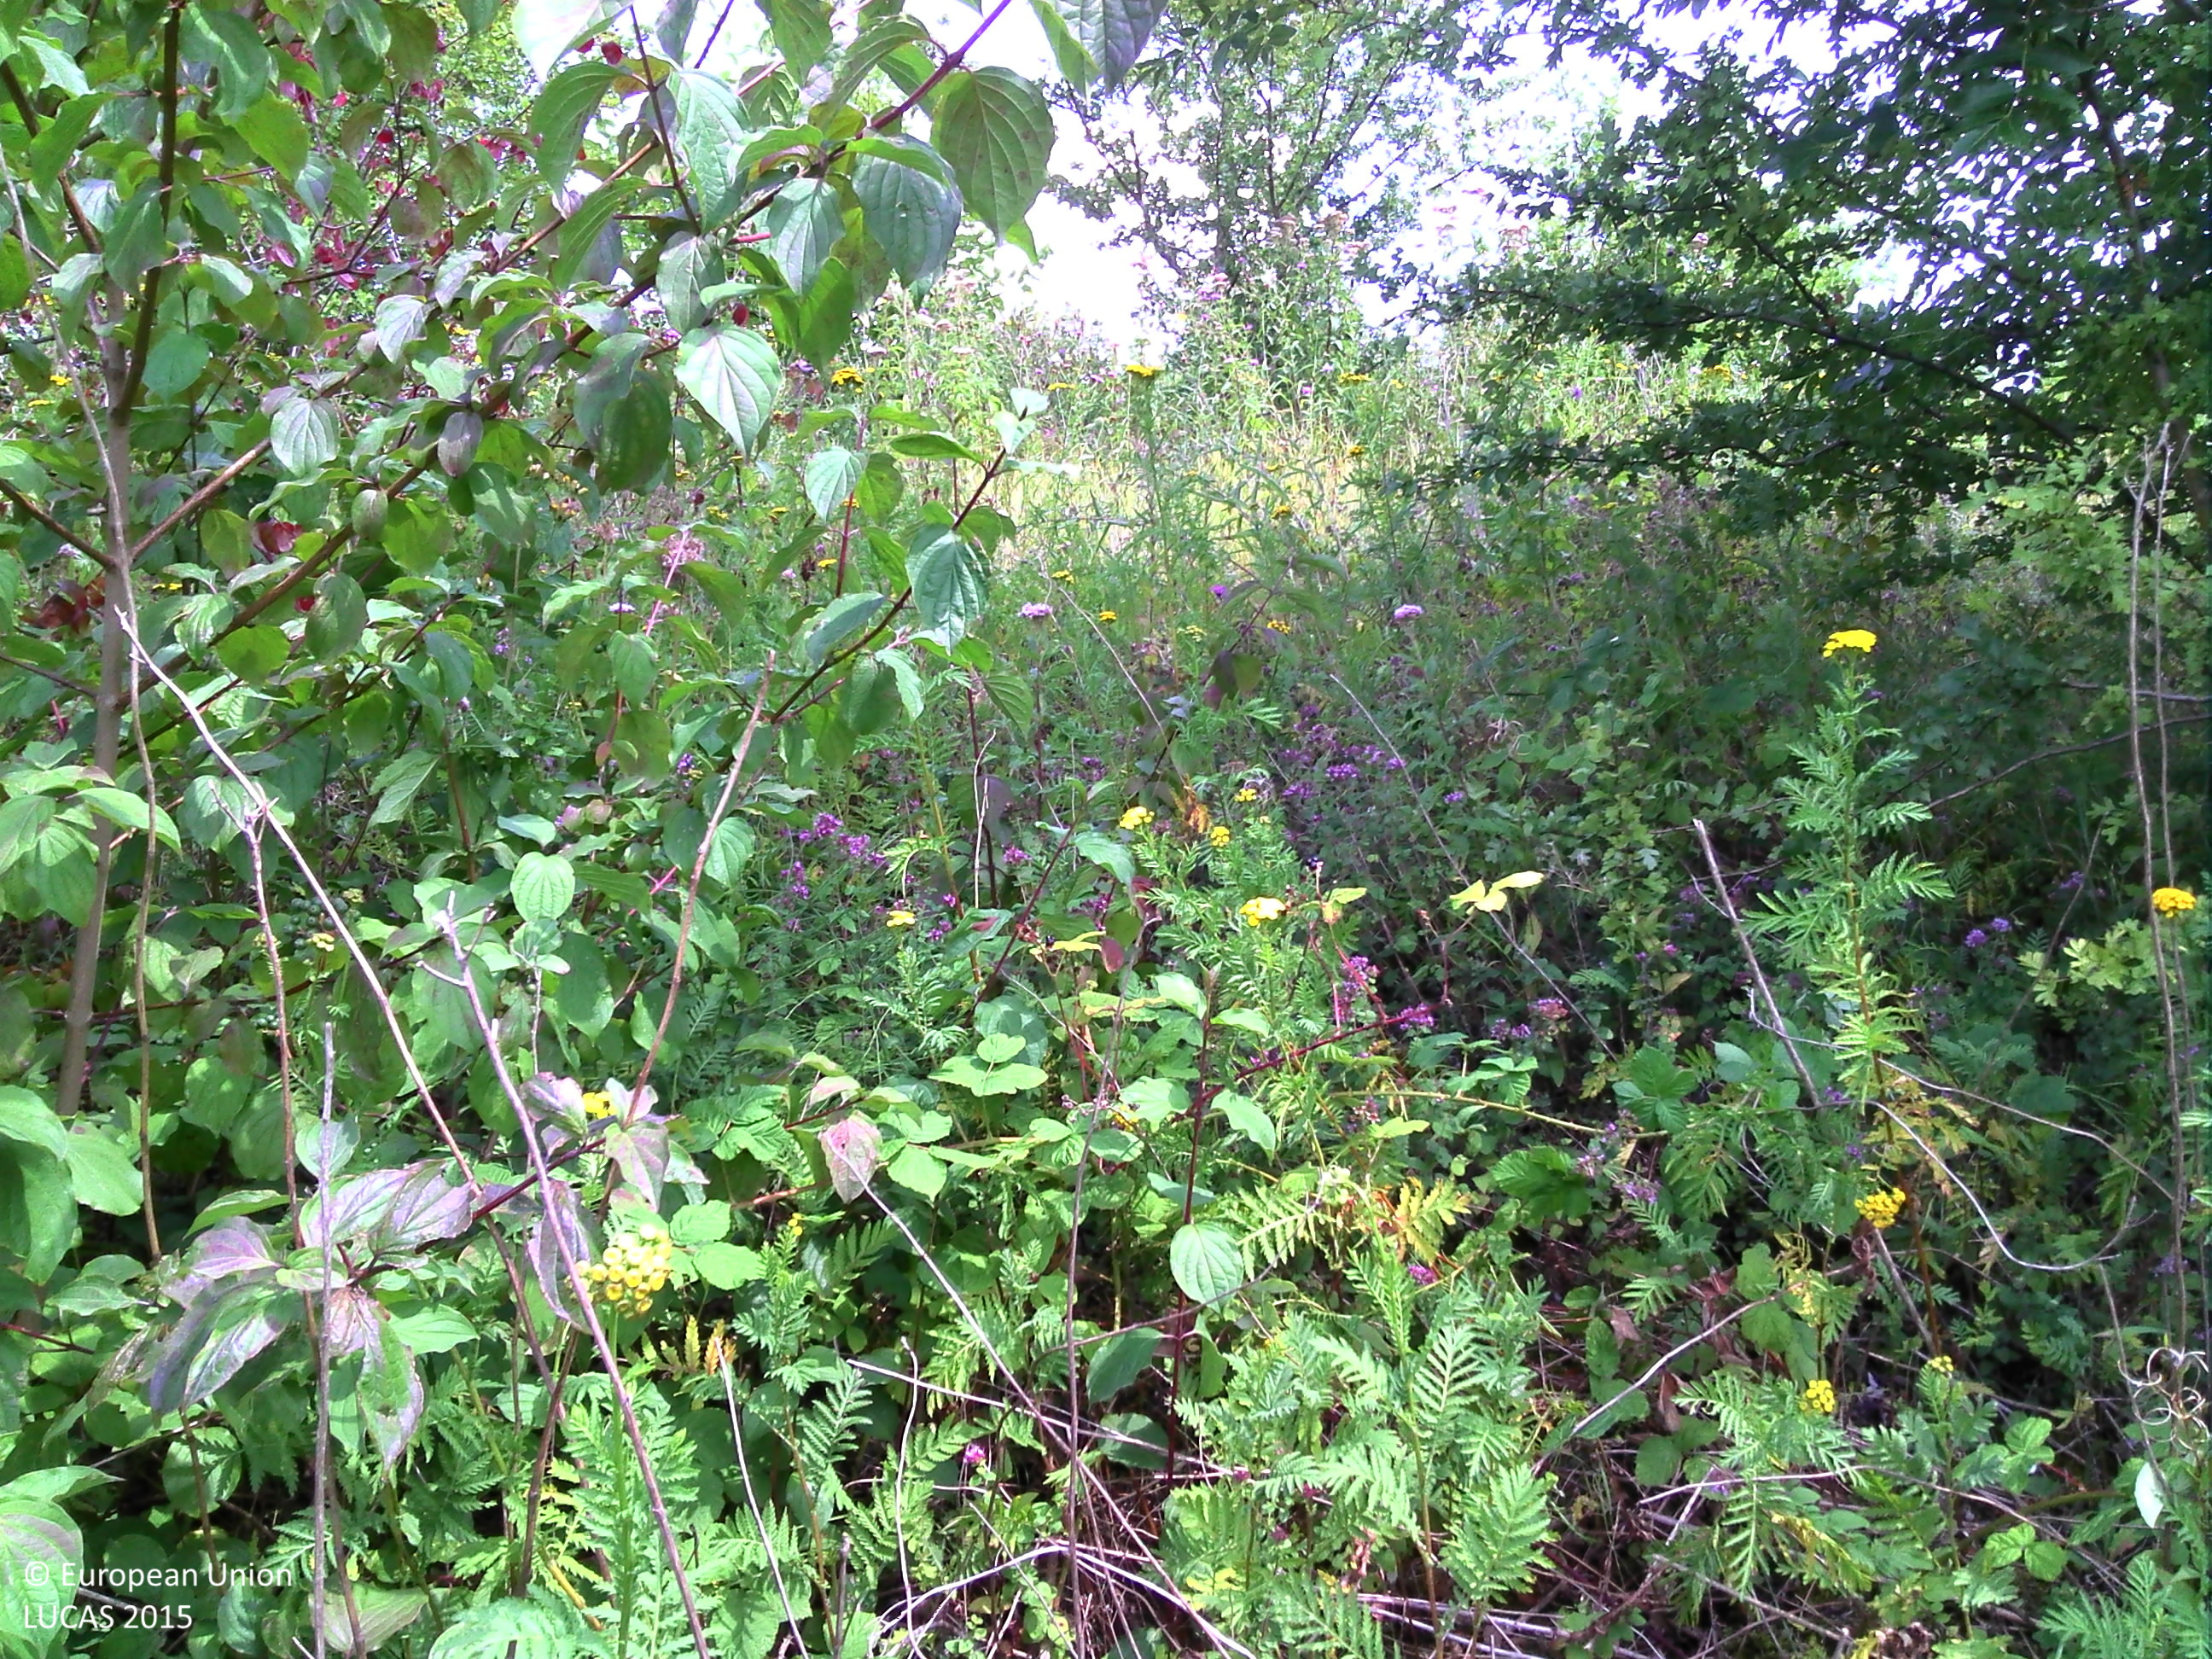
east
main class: Shrubland
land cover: Shrubland with sparse tree cover
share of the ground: > 75 %
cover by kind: shrubs 95 %, broadleaved forest trees 5 %
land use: Semi-natural and natural areas not in use
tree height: > 5 m
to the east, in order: Shrubland with sparse tree cover; Tracks; Shrubland with sparse tree cover; Tracks; Broadleaved woodland; Grassland without tree/shrub cover
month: July
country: BE
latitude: 50.6353
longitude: 5.4879
